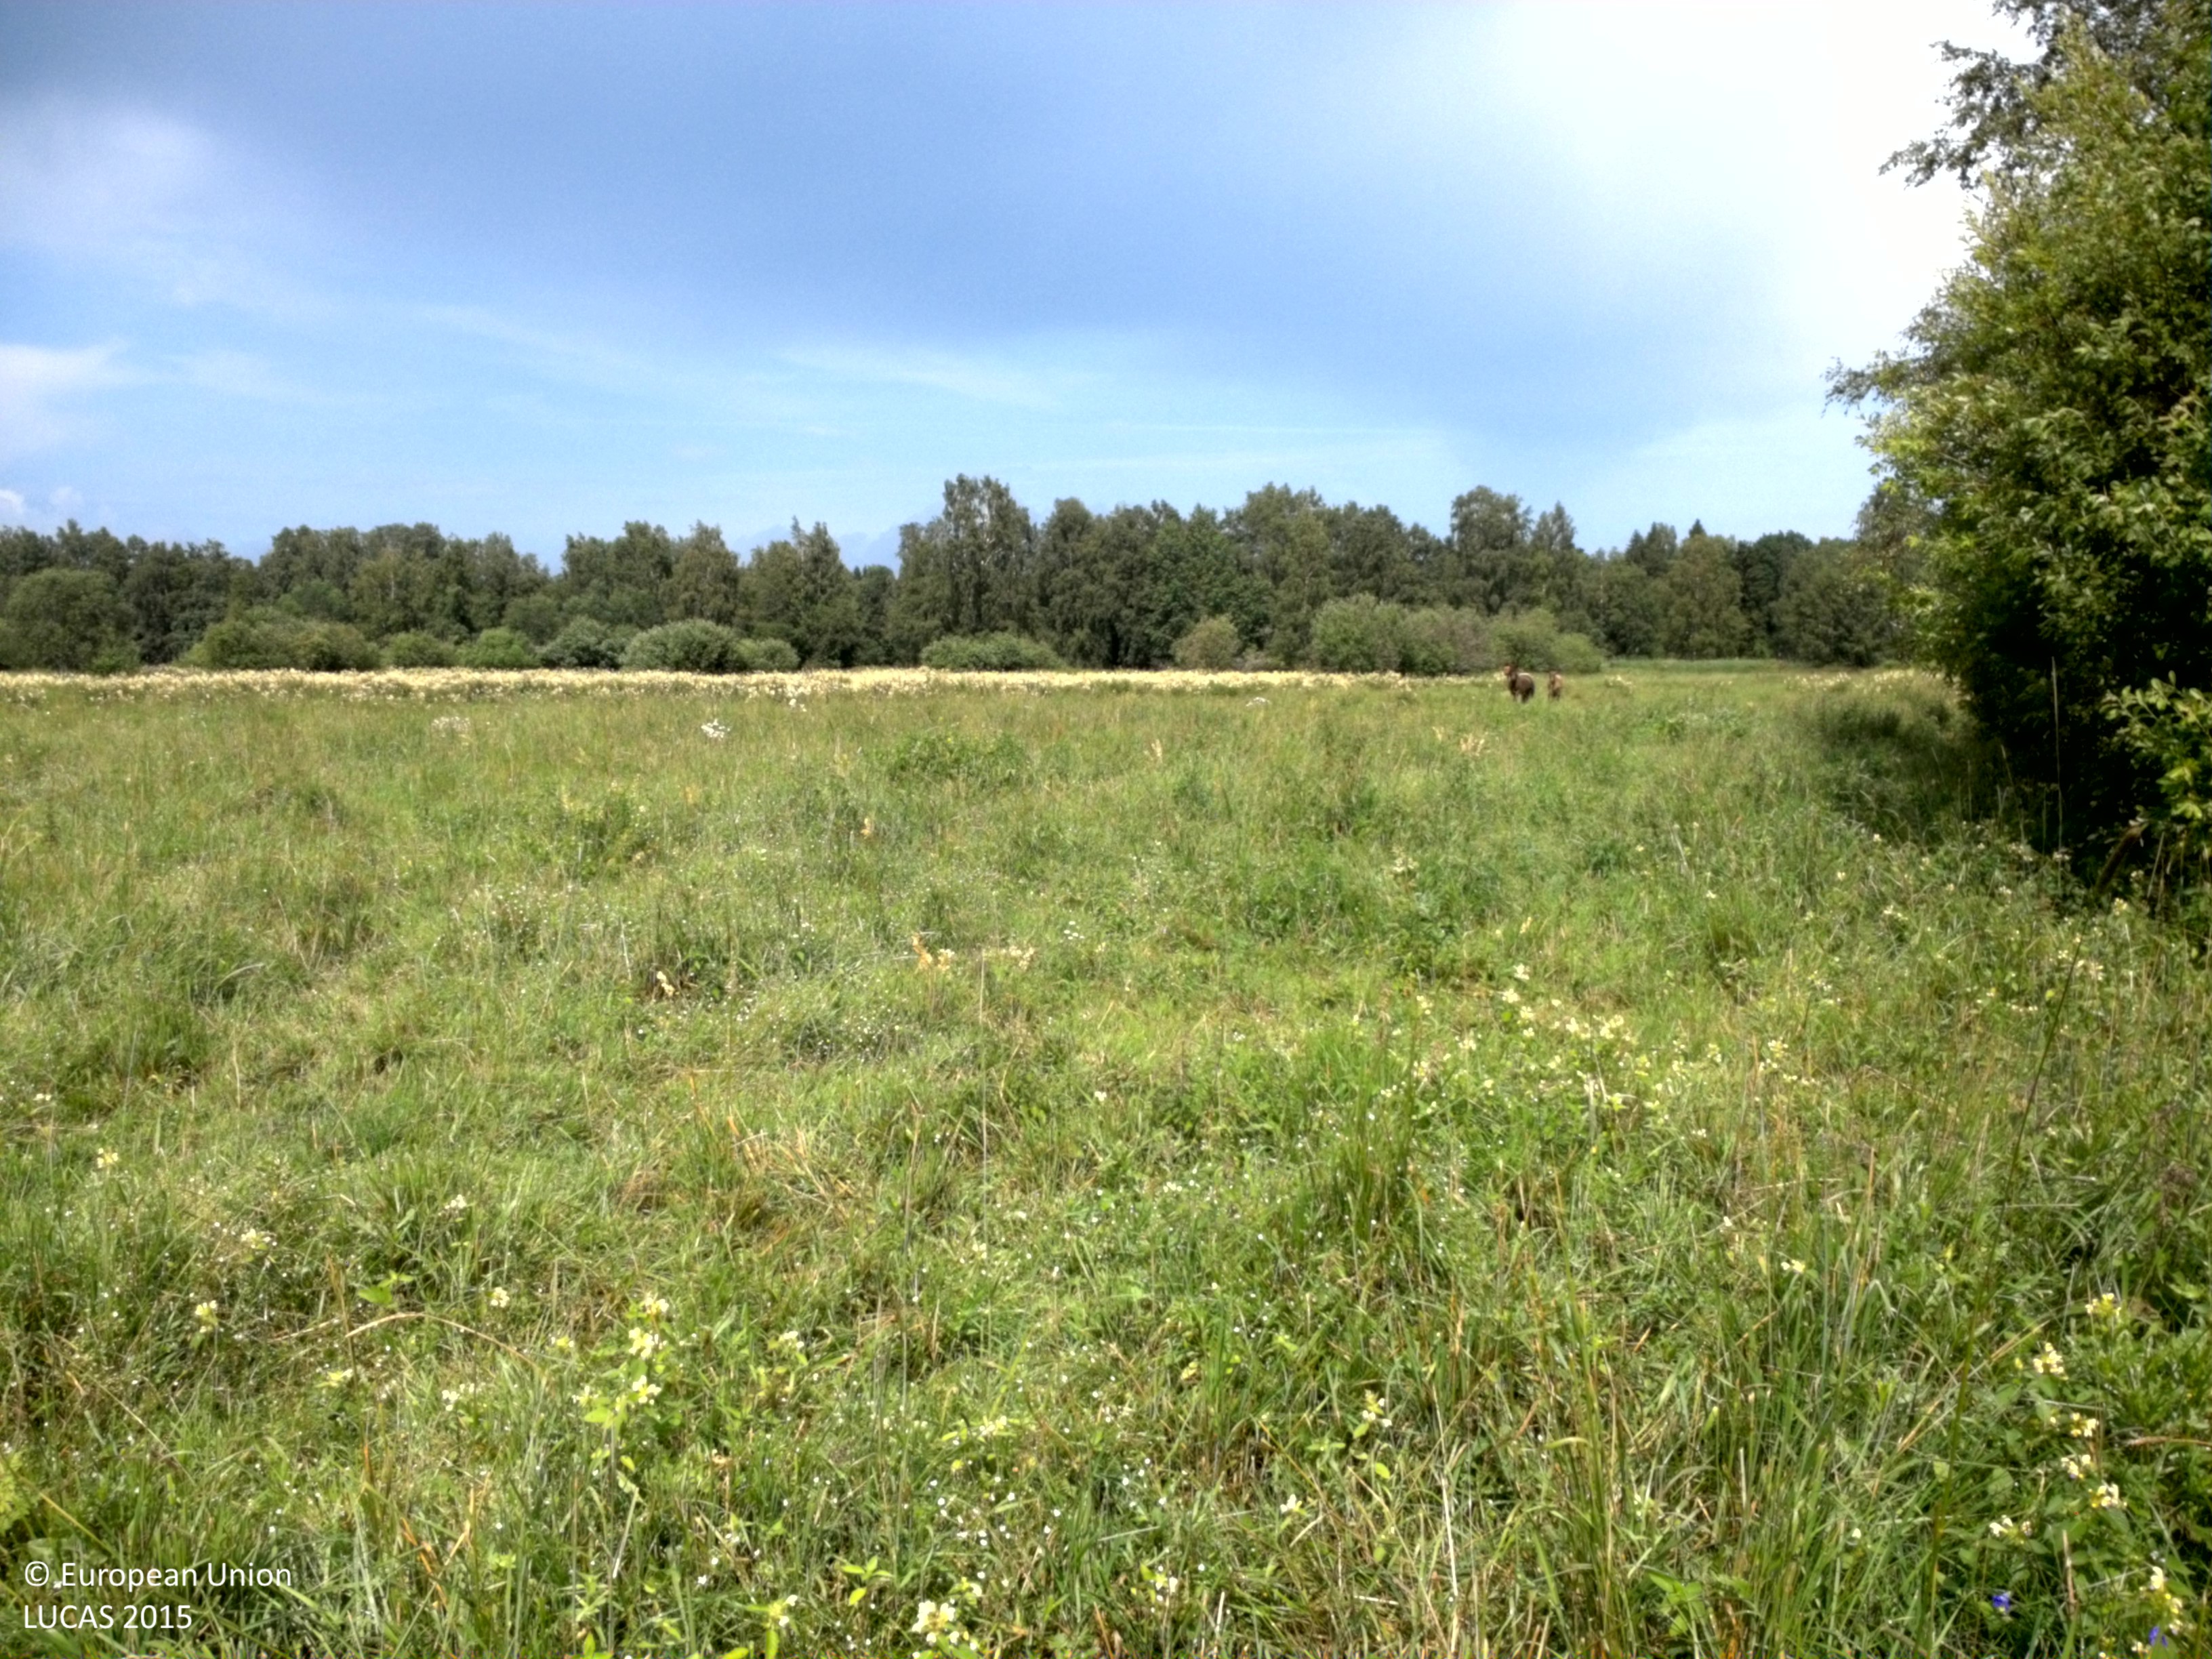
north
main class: Grassland
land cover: Grassland without tree/shrub cover
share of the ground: > 75 %
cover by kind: herbaceous plants 100 %
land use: Agriculture (excluding fallow land and kitchen gardens)
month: July
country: SE
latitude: 59.9534
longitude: 18.6108
